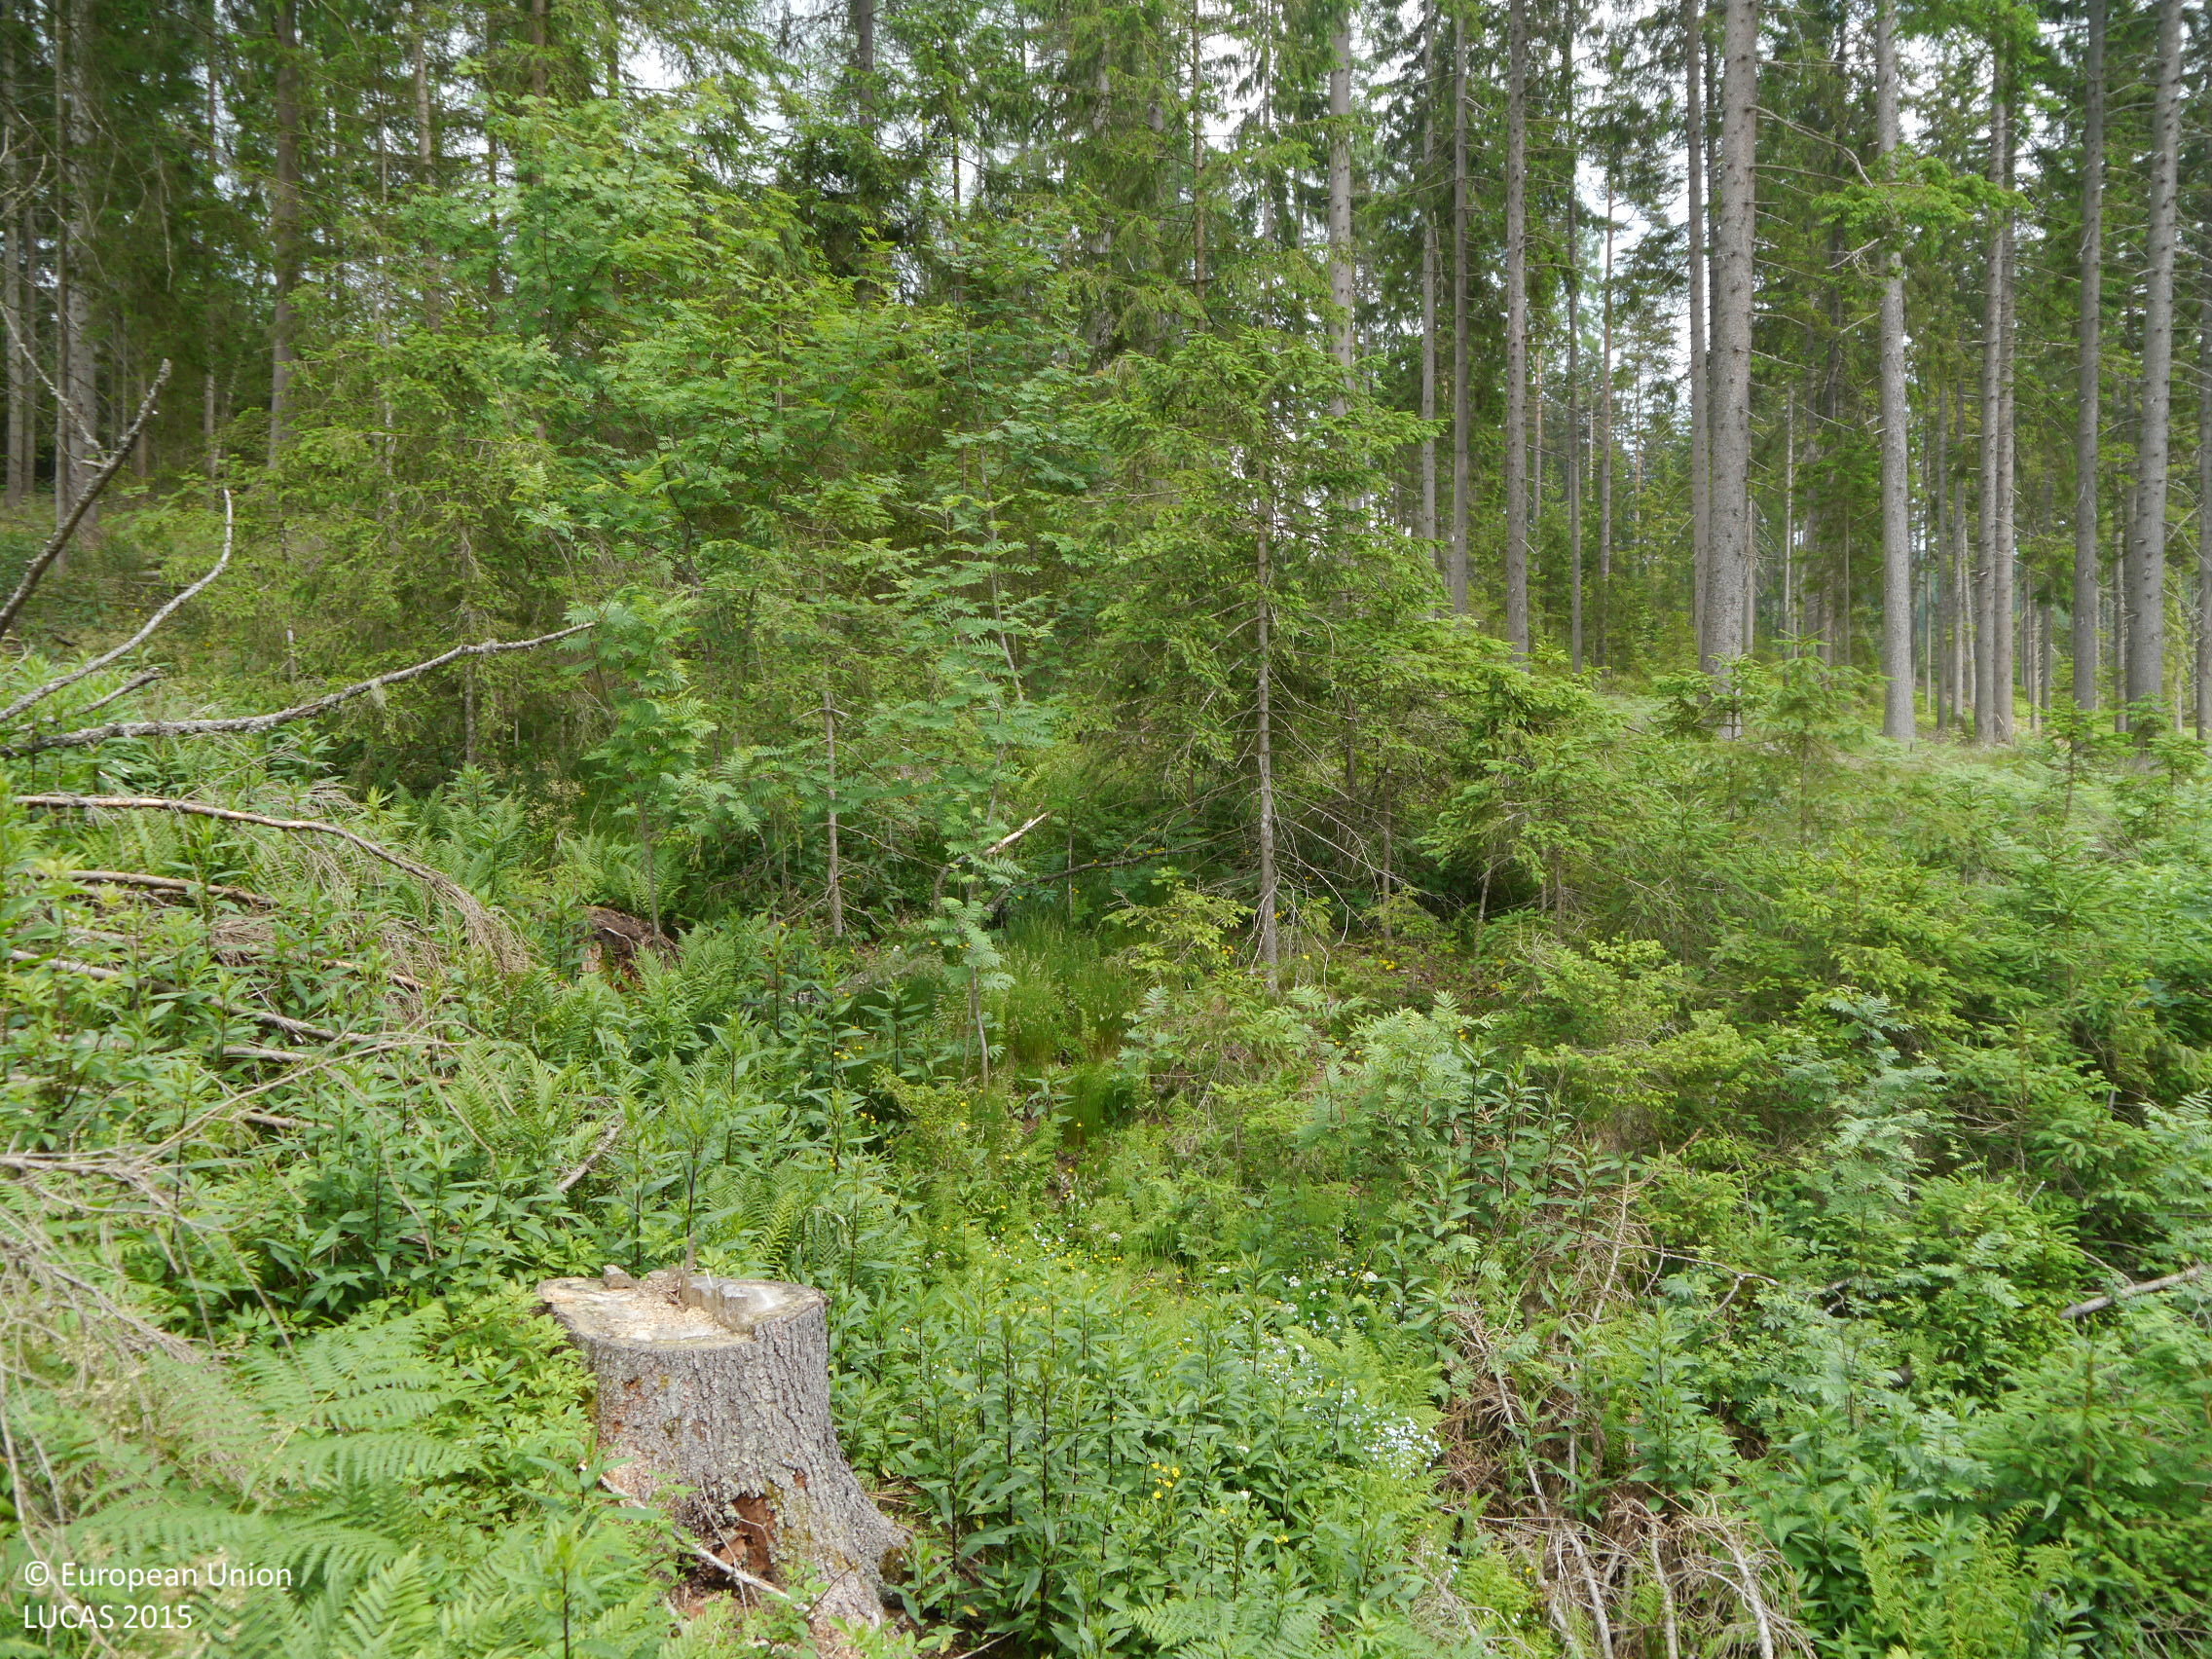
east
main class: Shrubland
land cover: Shrubland with sparse tree cover
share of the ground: > 75 %
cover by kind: shrubs 50 %, herbaceous plants 45 %, coniferous forest trees 5 %
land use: Forestry
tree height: > 5 m
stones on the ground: < 10 %
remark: Clear cut
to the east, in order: Shrubland with sparse tree cover; Tracks; Spruce dominated coniferous woodland; Tracks; Spruce dominated coniferous woodland; Fences; Grassland without tree/shrub cover; Fences; Tracks; Spruce dominated coniferous woodland
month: June
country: AT
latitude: 46.9402
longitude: 14.9512
